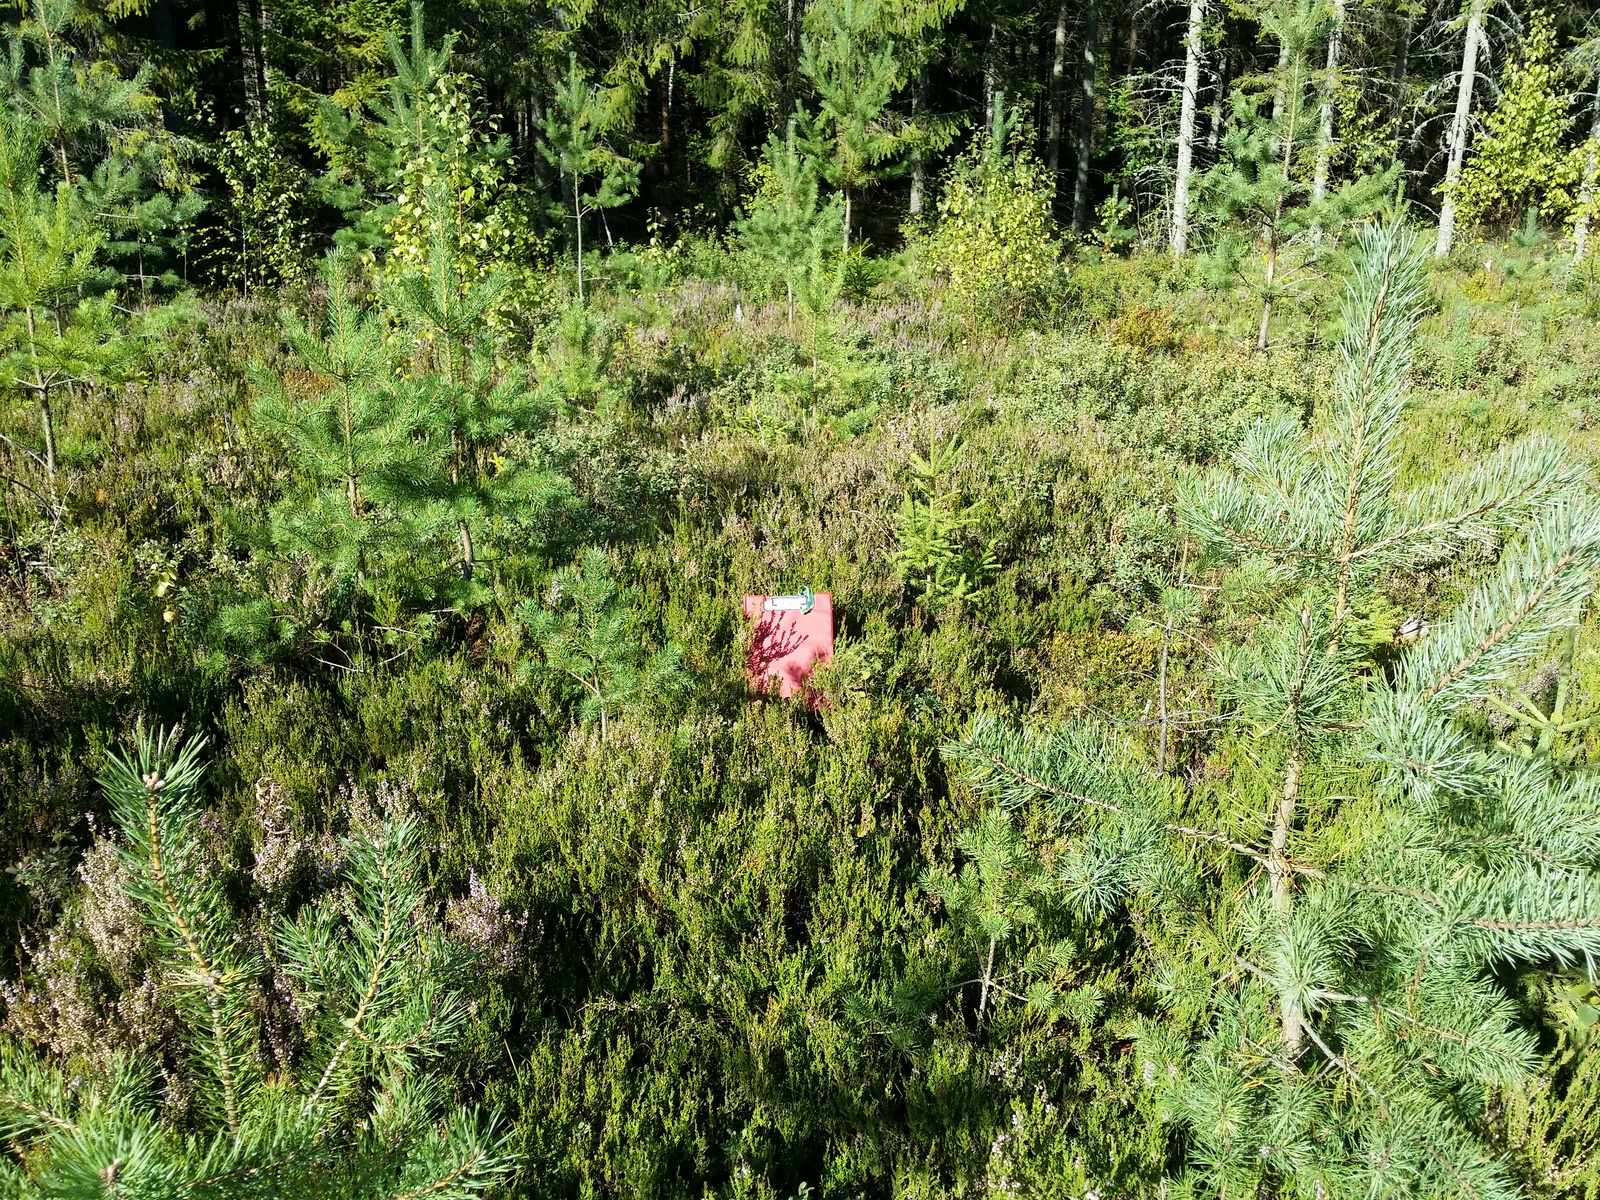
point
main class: Woodland
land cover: Other mixed woodland
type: hemiboreal forest and nemoral coniferous forest and mixed broadleaved-coniferous forest
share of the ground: 25 - 50 %
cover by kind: lichens and mosses 50 %, broadleaved forest trees 25 %, coniferous forest trees 15 %, herbaceous plants 10 %
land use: Forestry
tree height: < 5 m
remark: Nursery
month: August
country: LV
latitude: 57.2643
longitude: 27.6048
